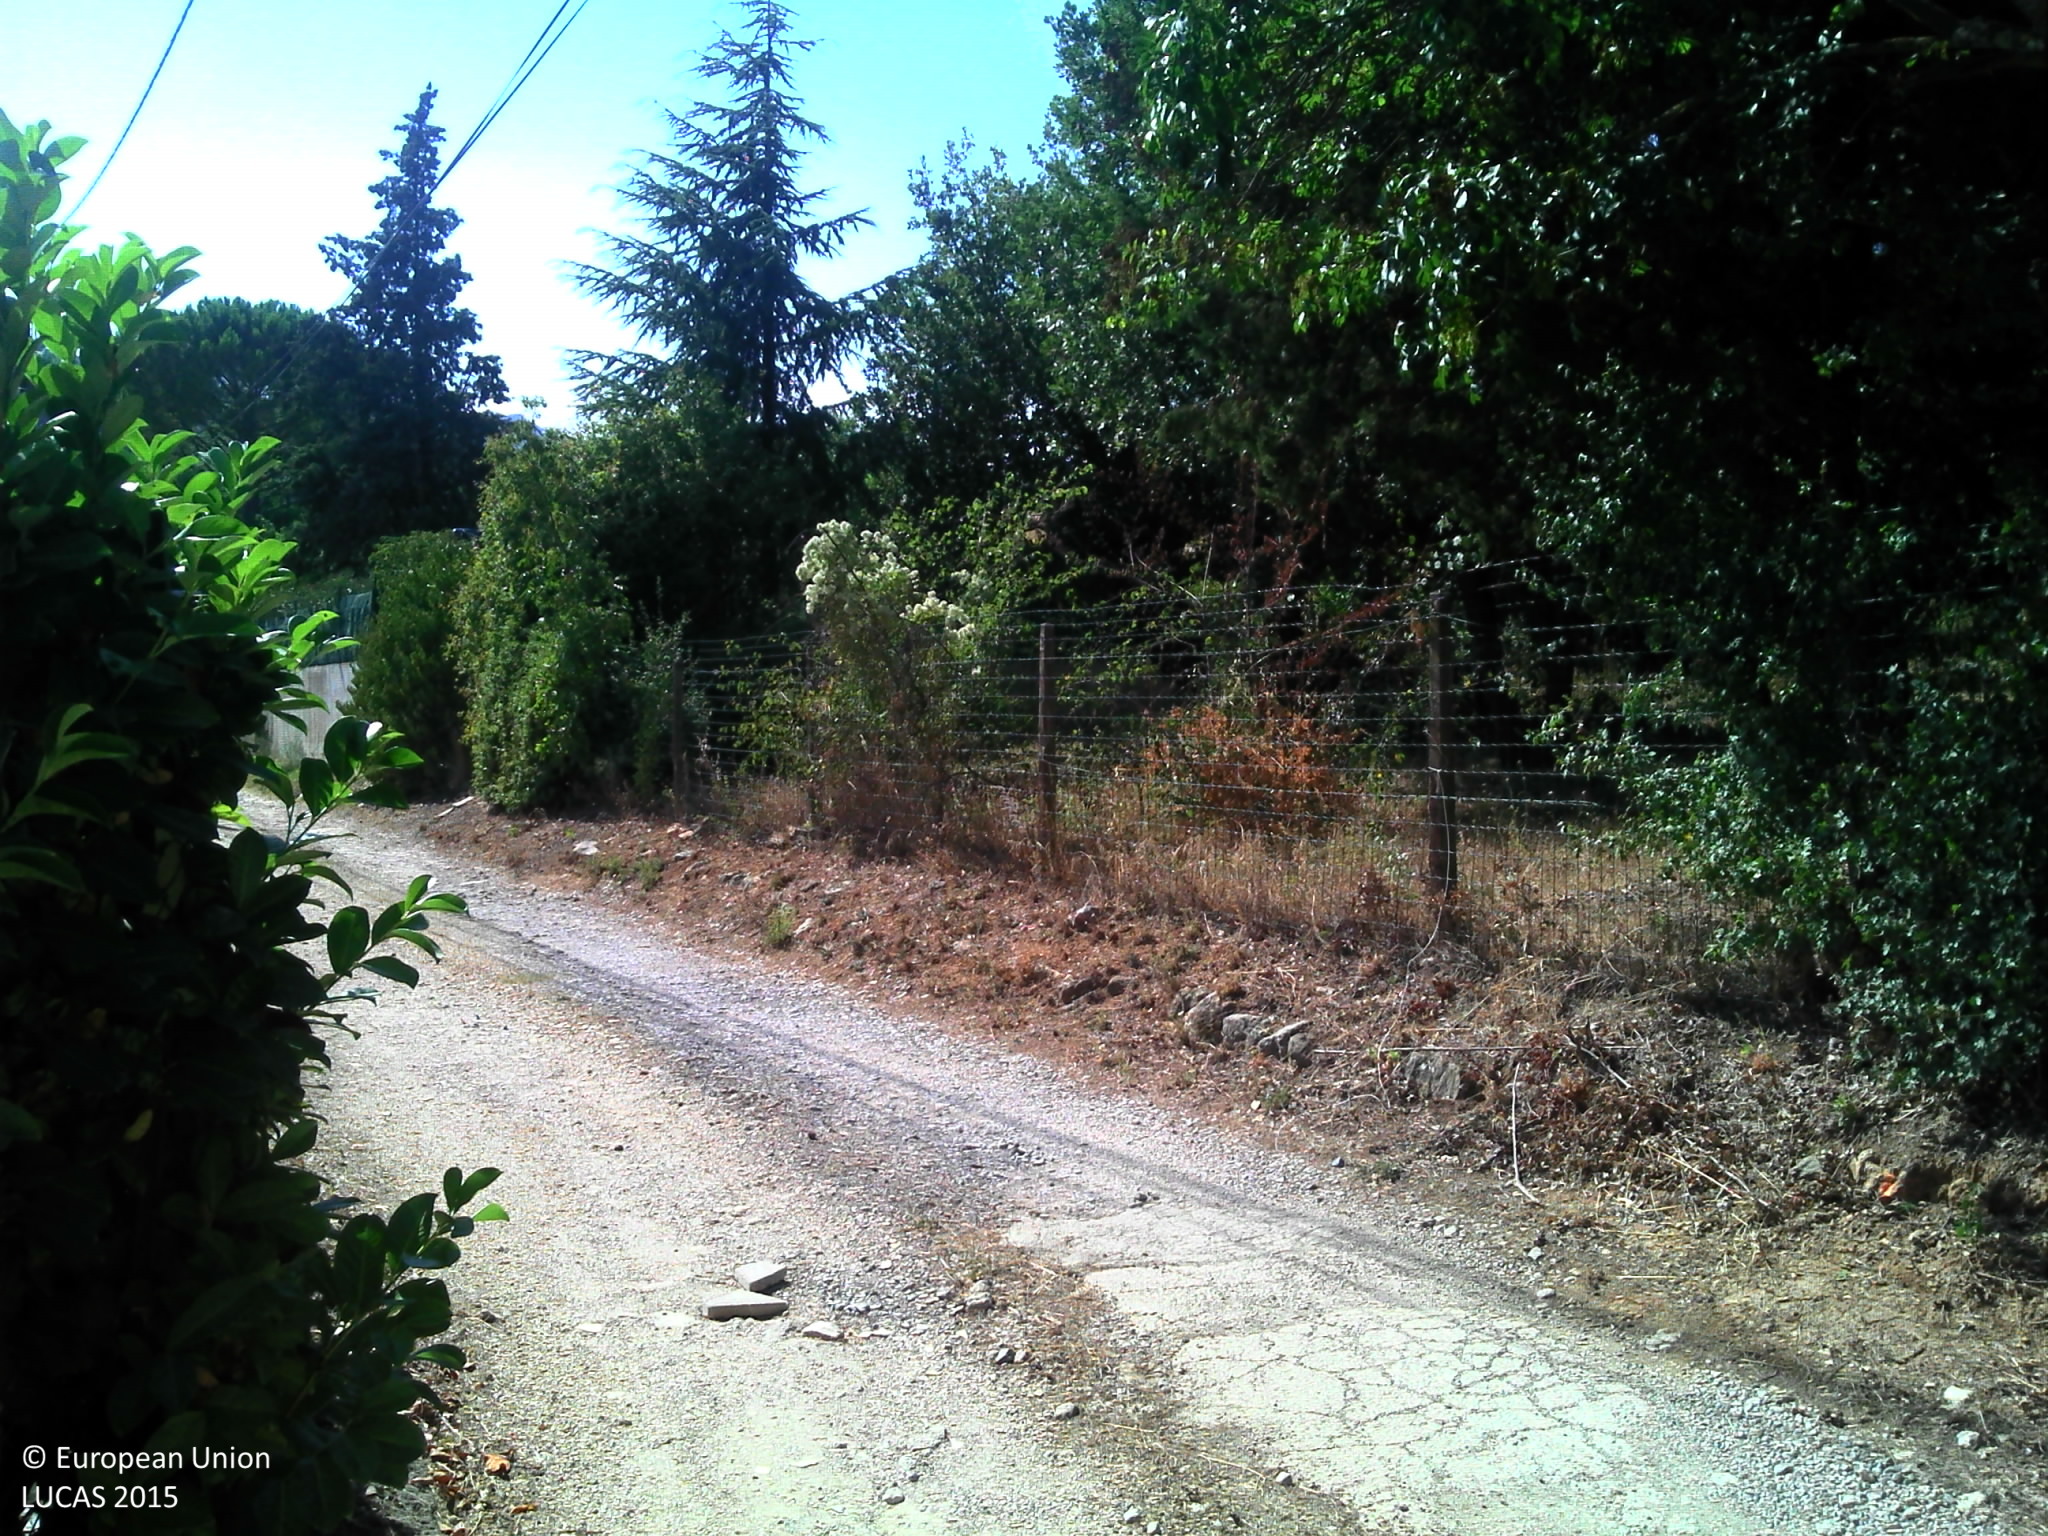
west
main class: Woodland
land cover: Broadleaved woodland
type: thermophilous deciduous forest
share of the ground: > 75 %
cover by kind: broadleaved forest trees 70 %, herbaceous plants 25 %, unconsolidated bare surface 5 %
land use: Residential
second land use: Forestry
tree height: > 5 m
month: August
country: FR
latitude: 43.3902
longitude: 5.6027
